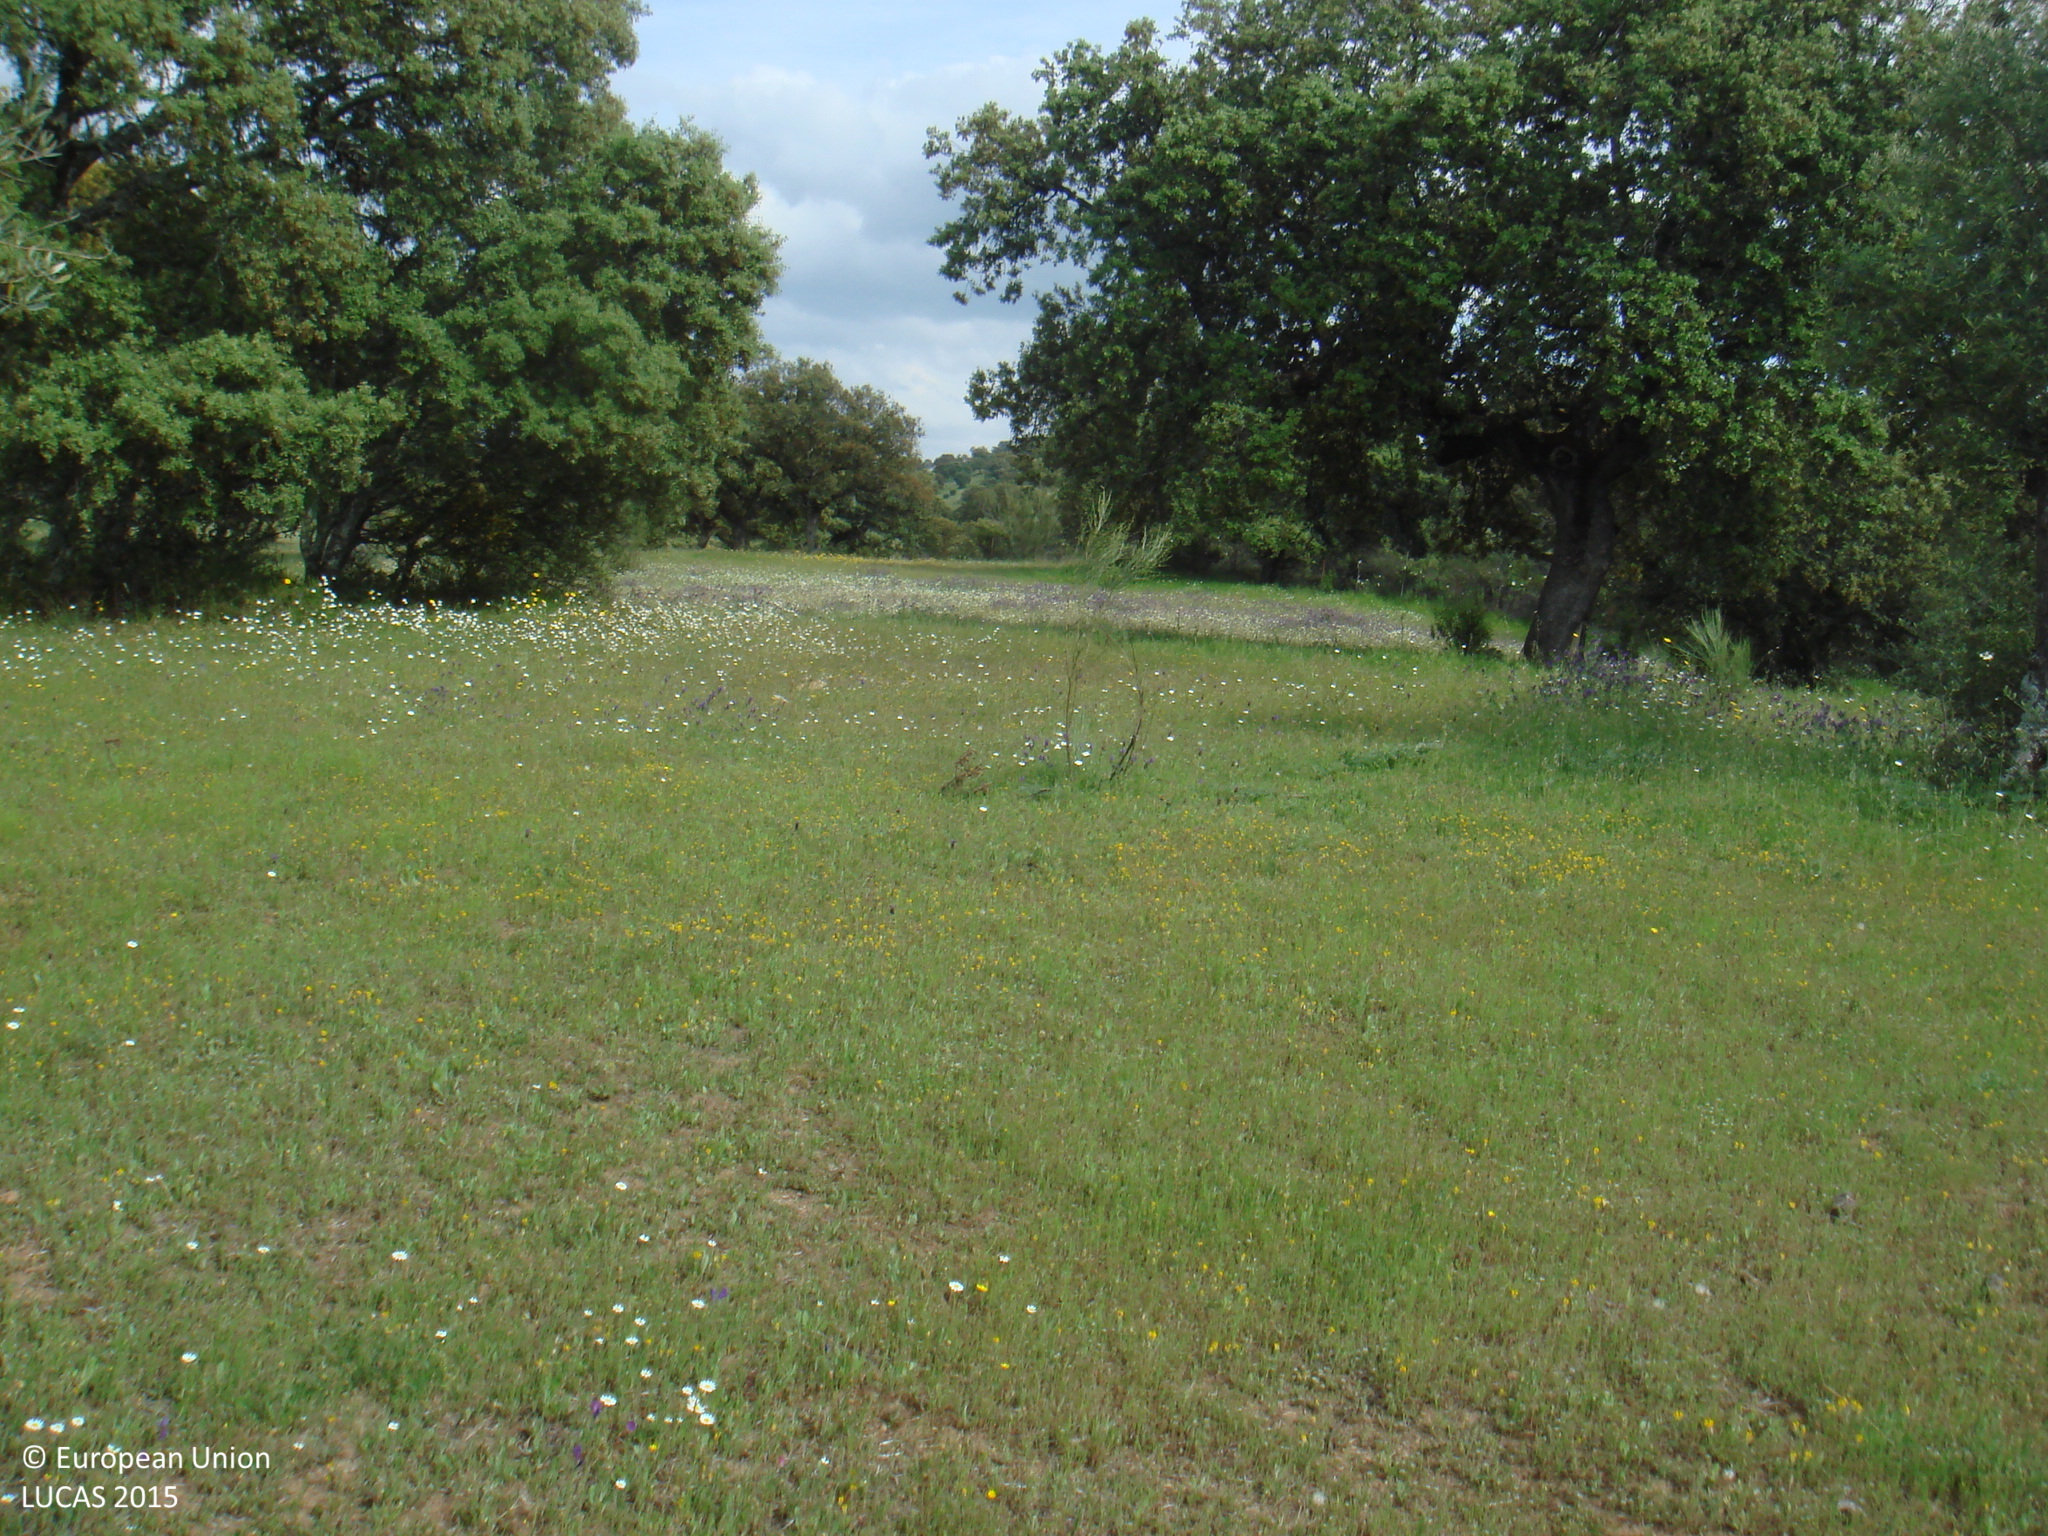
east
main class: Cropland
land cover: Olive groves
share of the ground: 10 - 25 %
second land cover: Grassland without tree/shrub cover
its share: > 75 %
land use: Agriculture (excluding fallow land and kitchen gardens)
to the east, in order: Olive groves; Grassland without tree/shrub cover; Broadleaved woodland
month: April
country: ES
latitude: 38.2036
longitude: -5.0170
